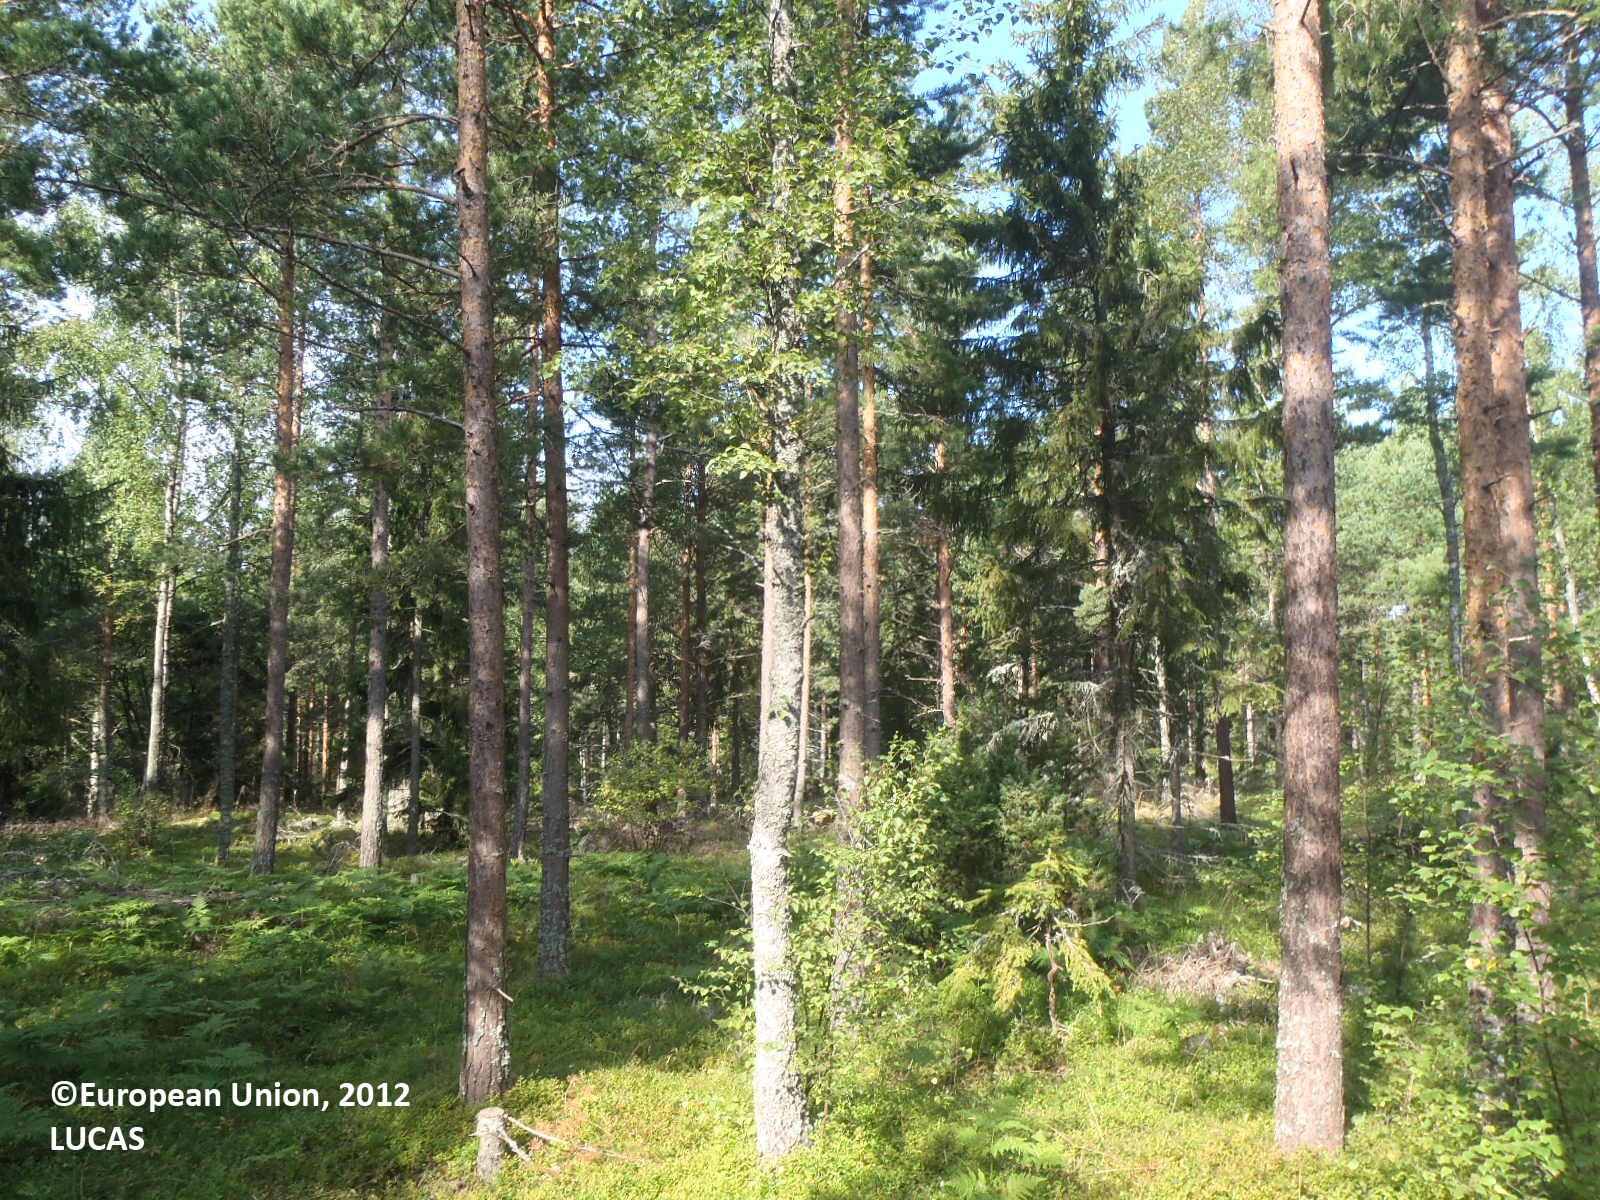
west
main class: Woodland
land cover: Pine dominated mixed woodland
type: hemiboreal forest and nemoral coniferous forest and mixed broadleaved-coniferous forest
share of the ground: 50 - 75 %
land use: Forestry
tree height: > 5 m
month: August
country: FI
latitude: 60.1867
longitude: 20.2694
